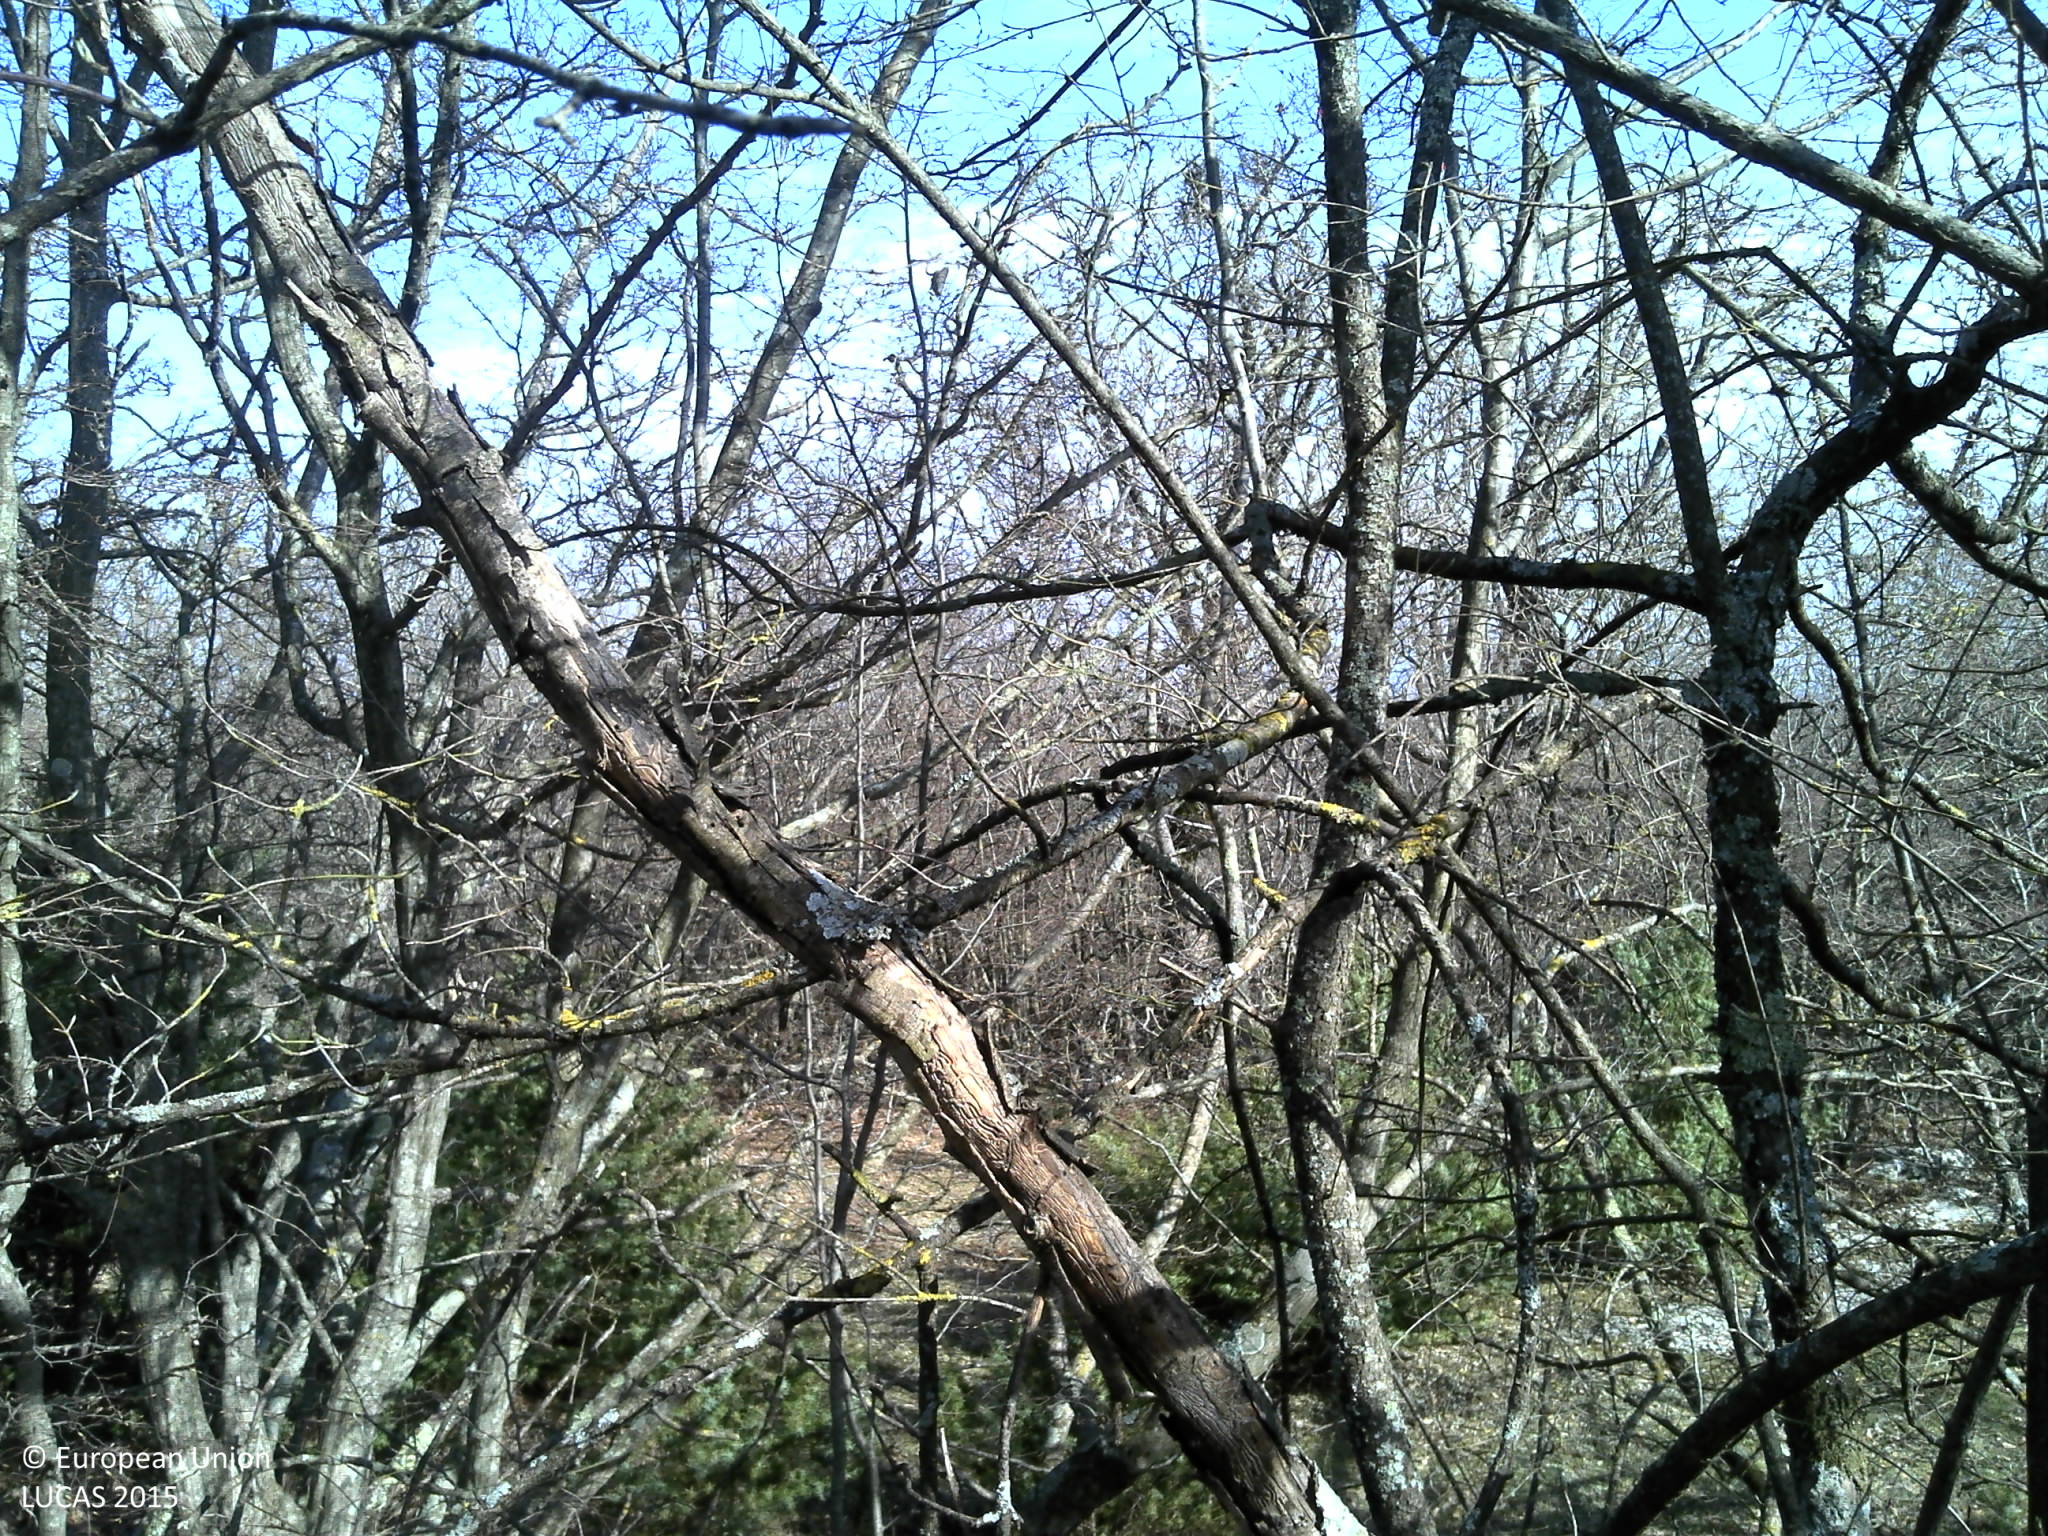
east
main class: Woodland
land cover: Broadleaved woodland
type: thermophilous deciduous forest
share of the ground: > 75 %
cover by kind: broadleaved forest trees 80 %, shrubs 10 %, herbaceous plants 5 %, lichens and mosses 5 %
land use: Semi-natural and natural areas not in use
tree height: > 5 m
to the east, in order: Broadleaved woodland; Dry stone walls; Broadleaved woodland; Grassland with sparse tree/shrub cover; Broadleaved woodland; Dry stone walls; Grassland with sparse tree/shrub cover; Dry stone walls; Grassland with sparse tree/shrub cover
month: March
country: HR
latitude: 44.0383
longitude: 15.8947
